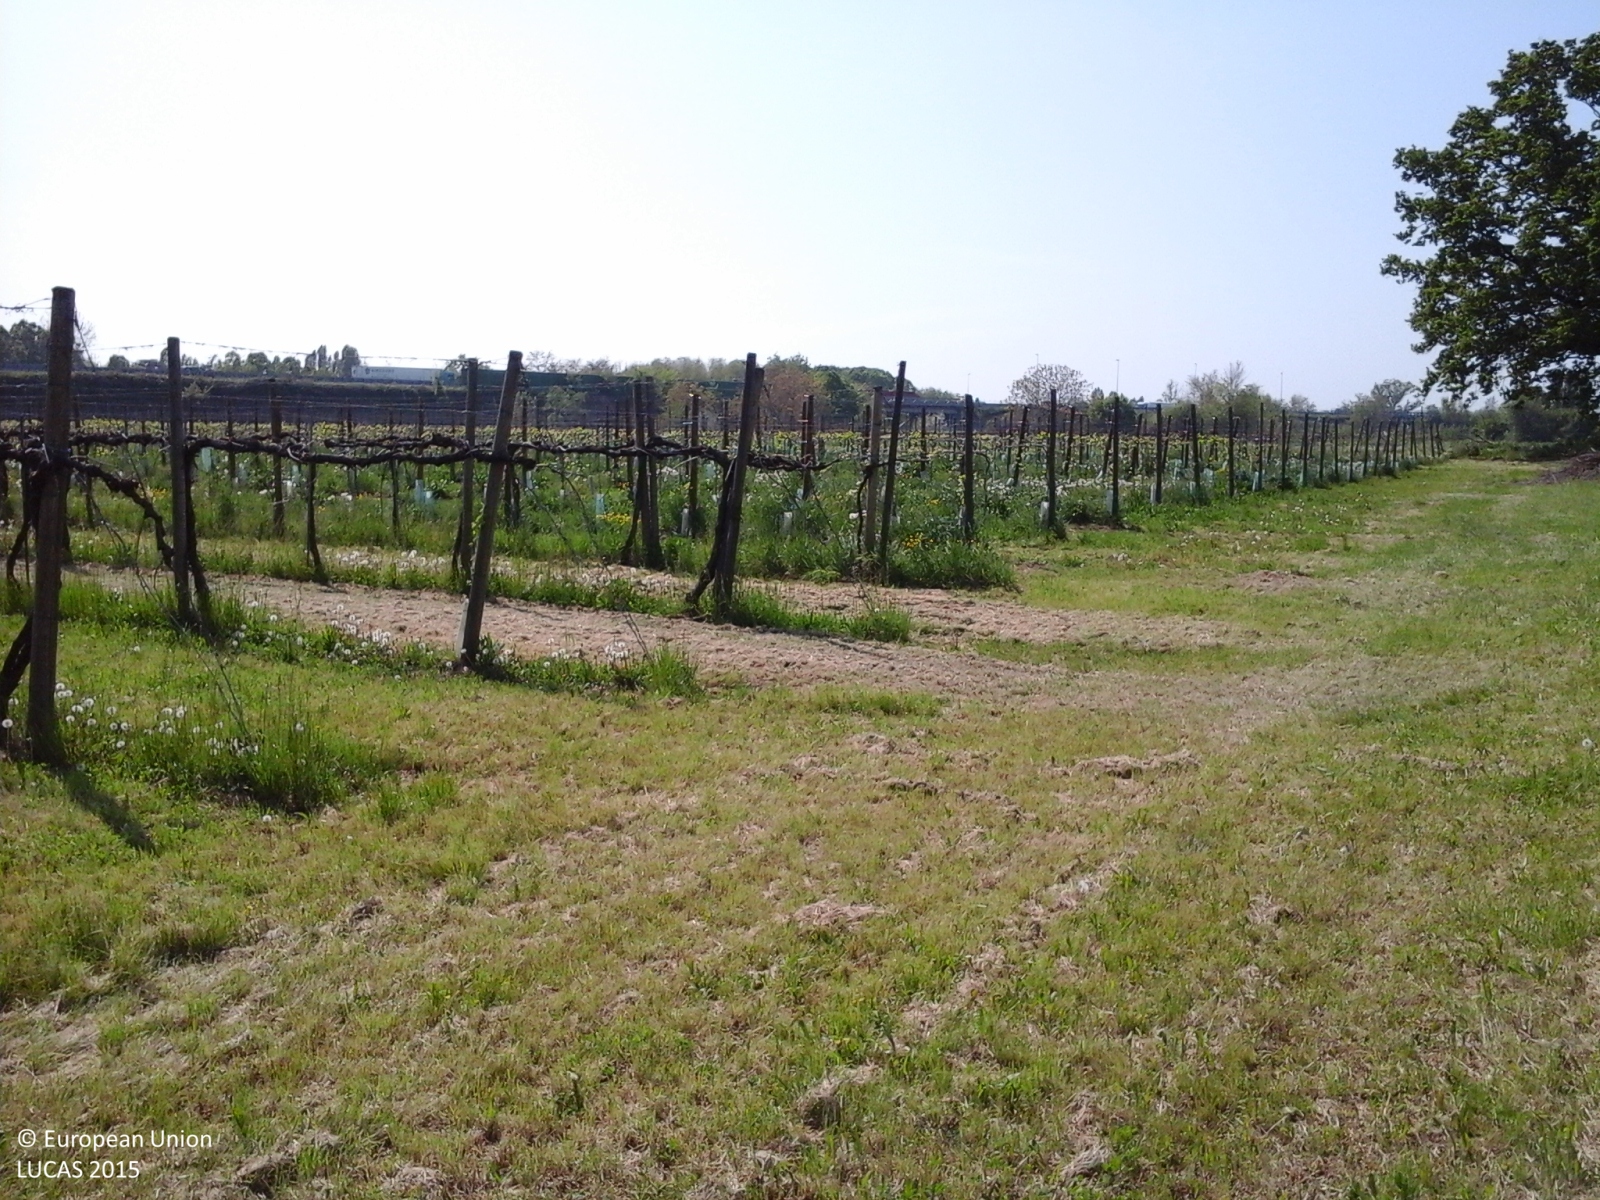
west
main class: Grassland
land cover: Spontaneously vegetated surfaces
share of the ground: > 75 %
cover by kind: herbaceous plants 100 %
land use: Agriculture (excluding fallow land and kitchen gardens)
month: April
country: IT
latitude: 44.6172
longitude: 10.8928
